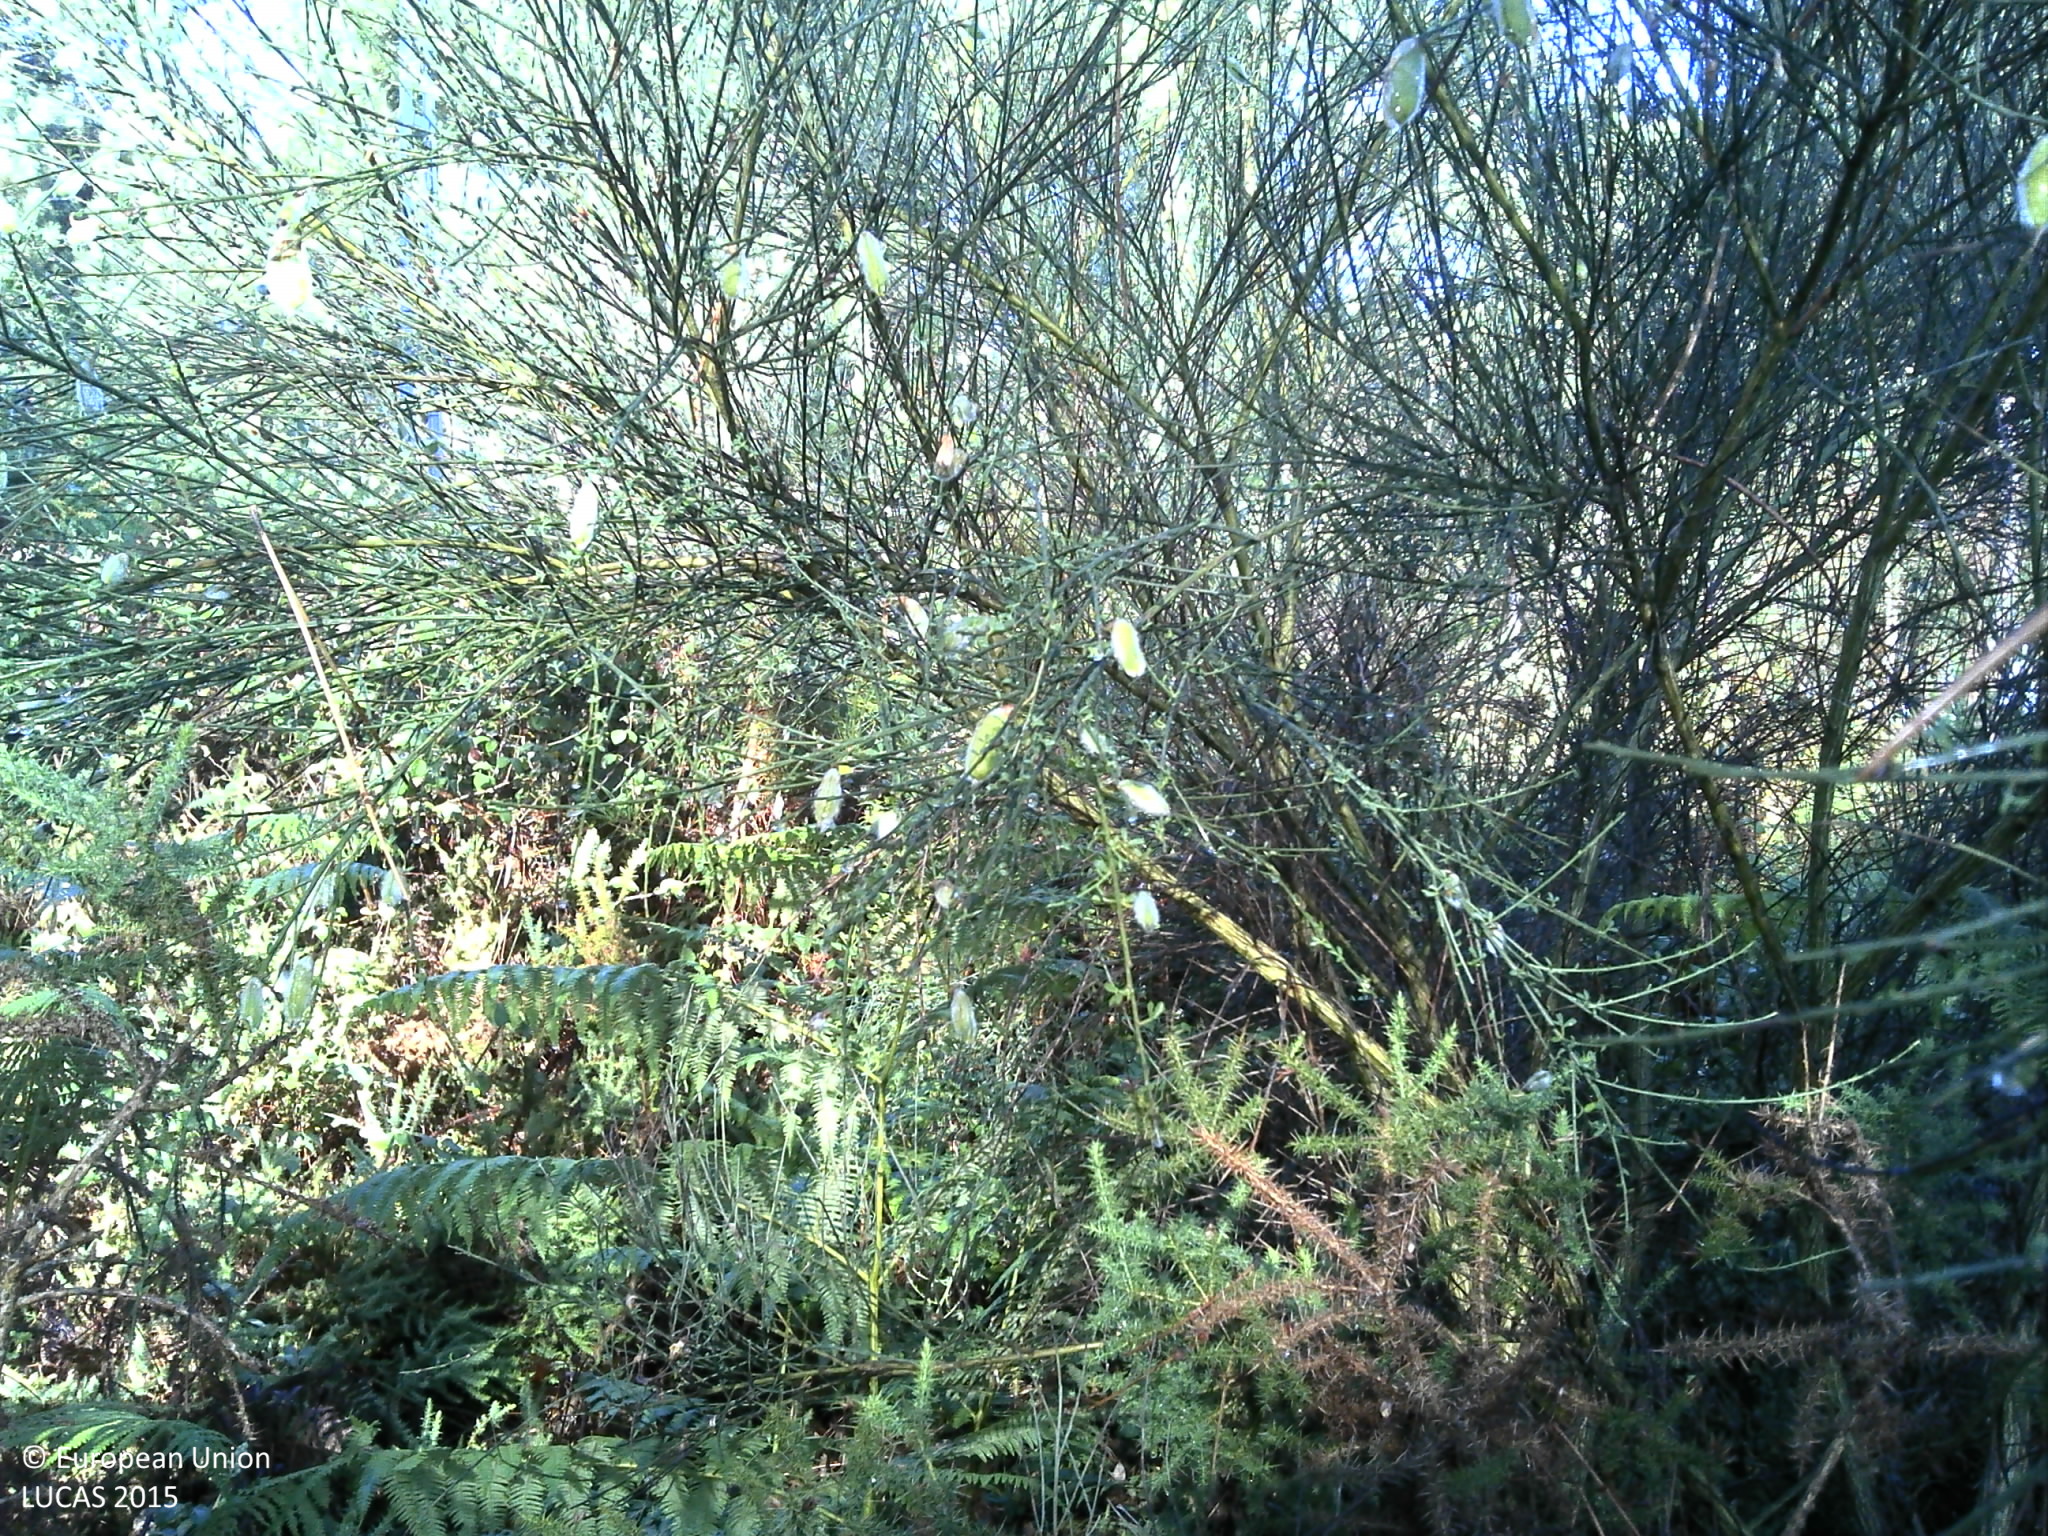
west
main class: Woodland
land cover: Pine dominated coniferous woodland
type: coniferous forest of the mediterranean region
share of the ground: 10 - 25 %
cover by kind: unconsolidated bare surface 45 %, shrubs 35 %, coniferous forest trees 20 %
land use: Forestry
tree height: > 5 m
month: June
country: PT
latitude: 41.2405
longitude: -7.6308
